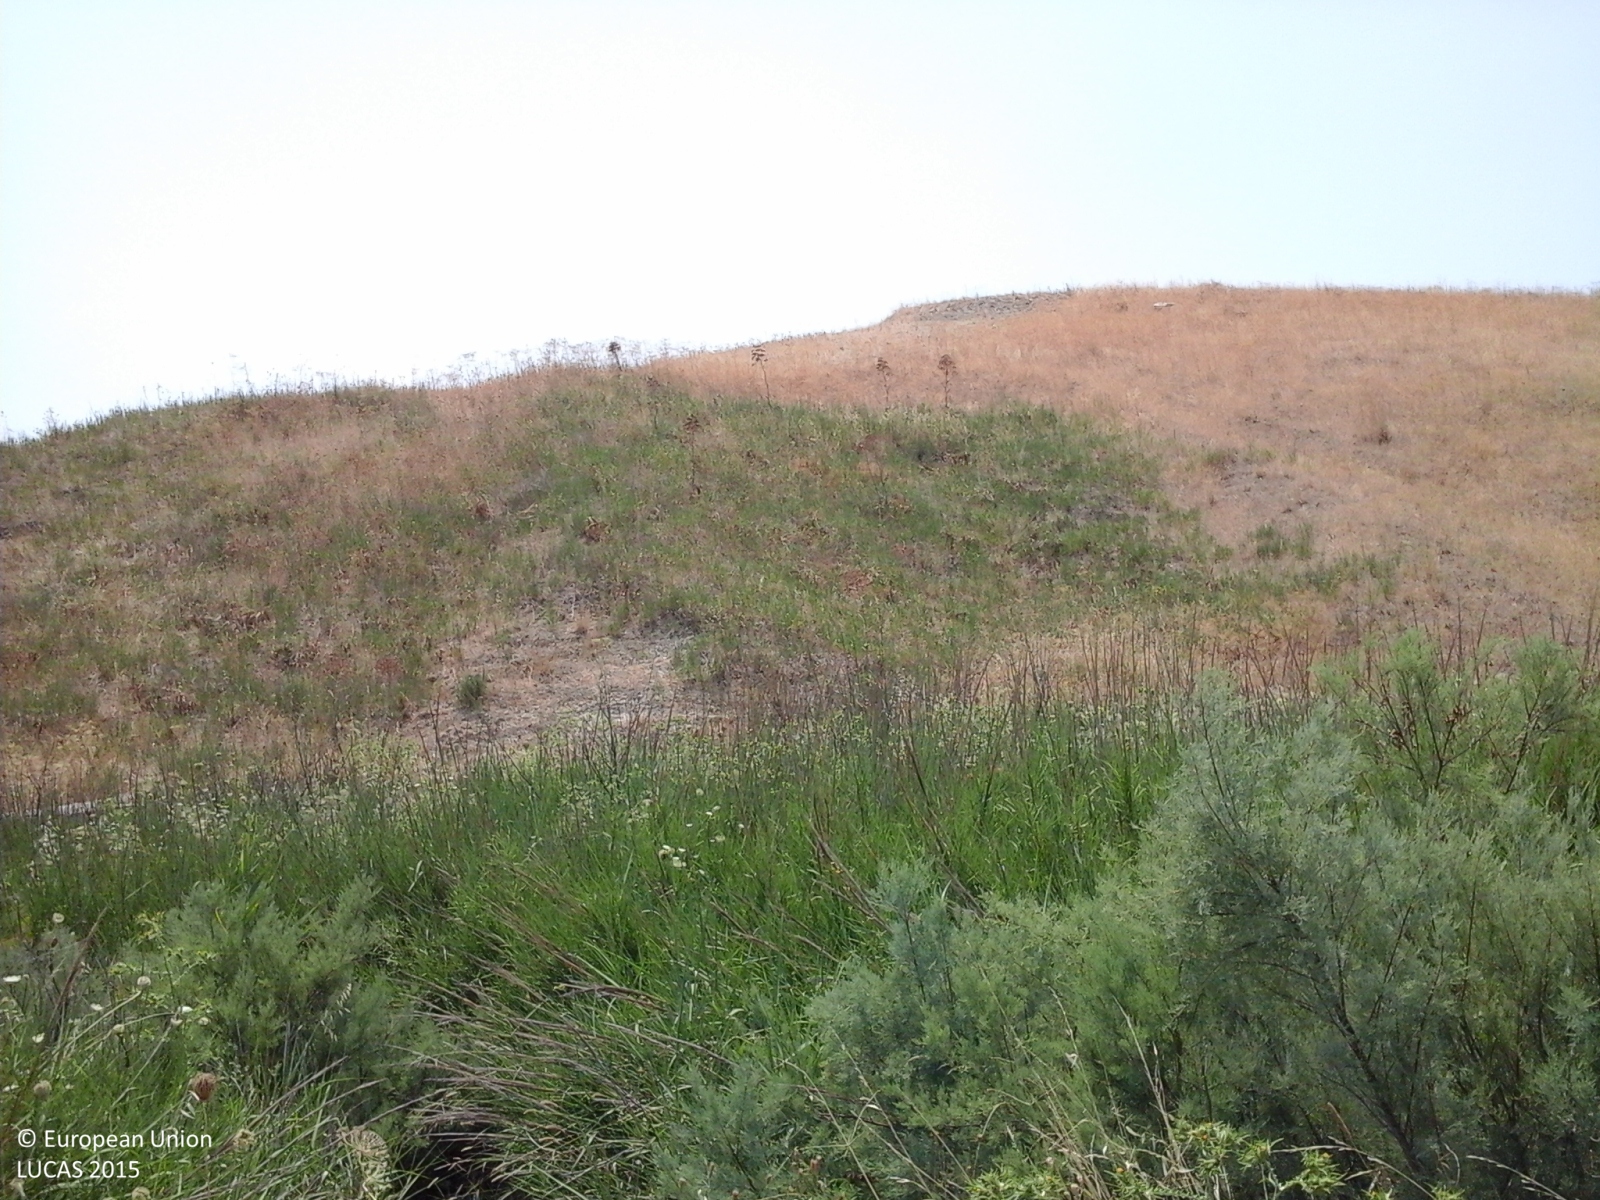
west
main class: Grassland
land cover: Grassland without tree/shrub cover
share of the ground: > 75 %
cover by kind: herbaceous plants 100 %
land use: Semi-natural and natural areas not in use
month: July
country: IT
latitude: 37.3381
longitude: 13.9540
